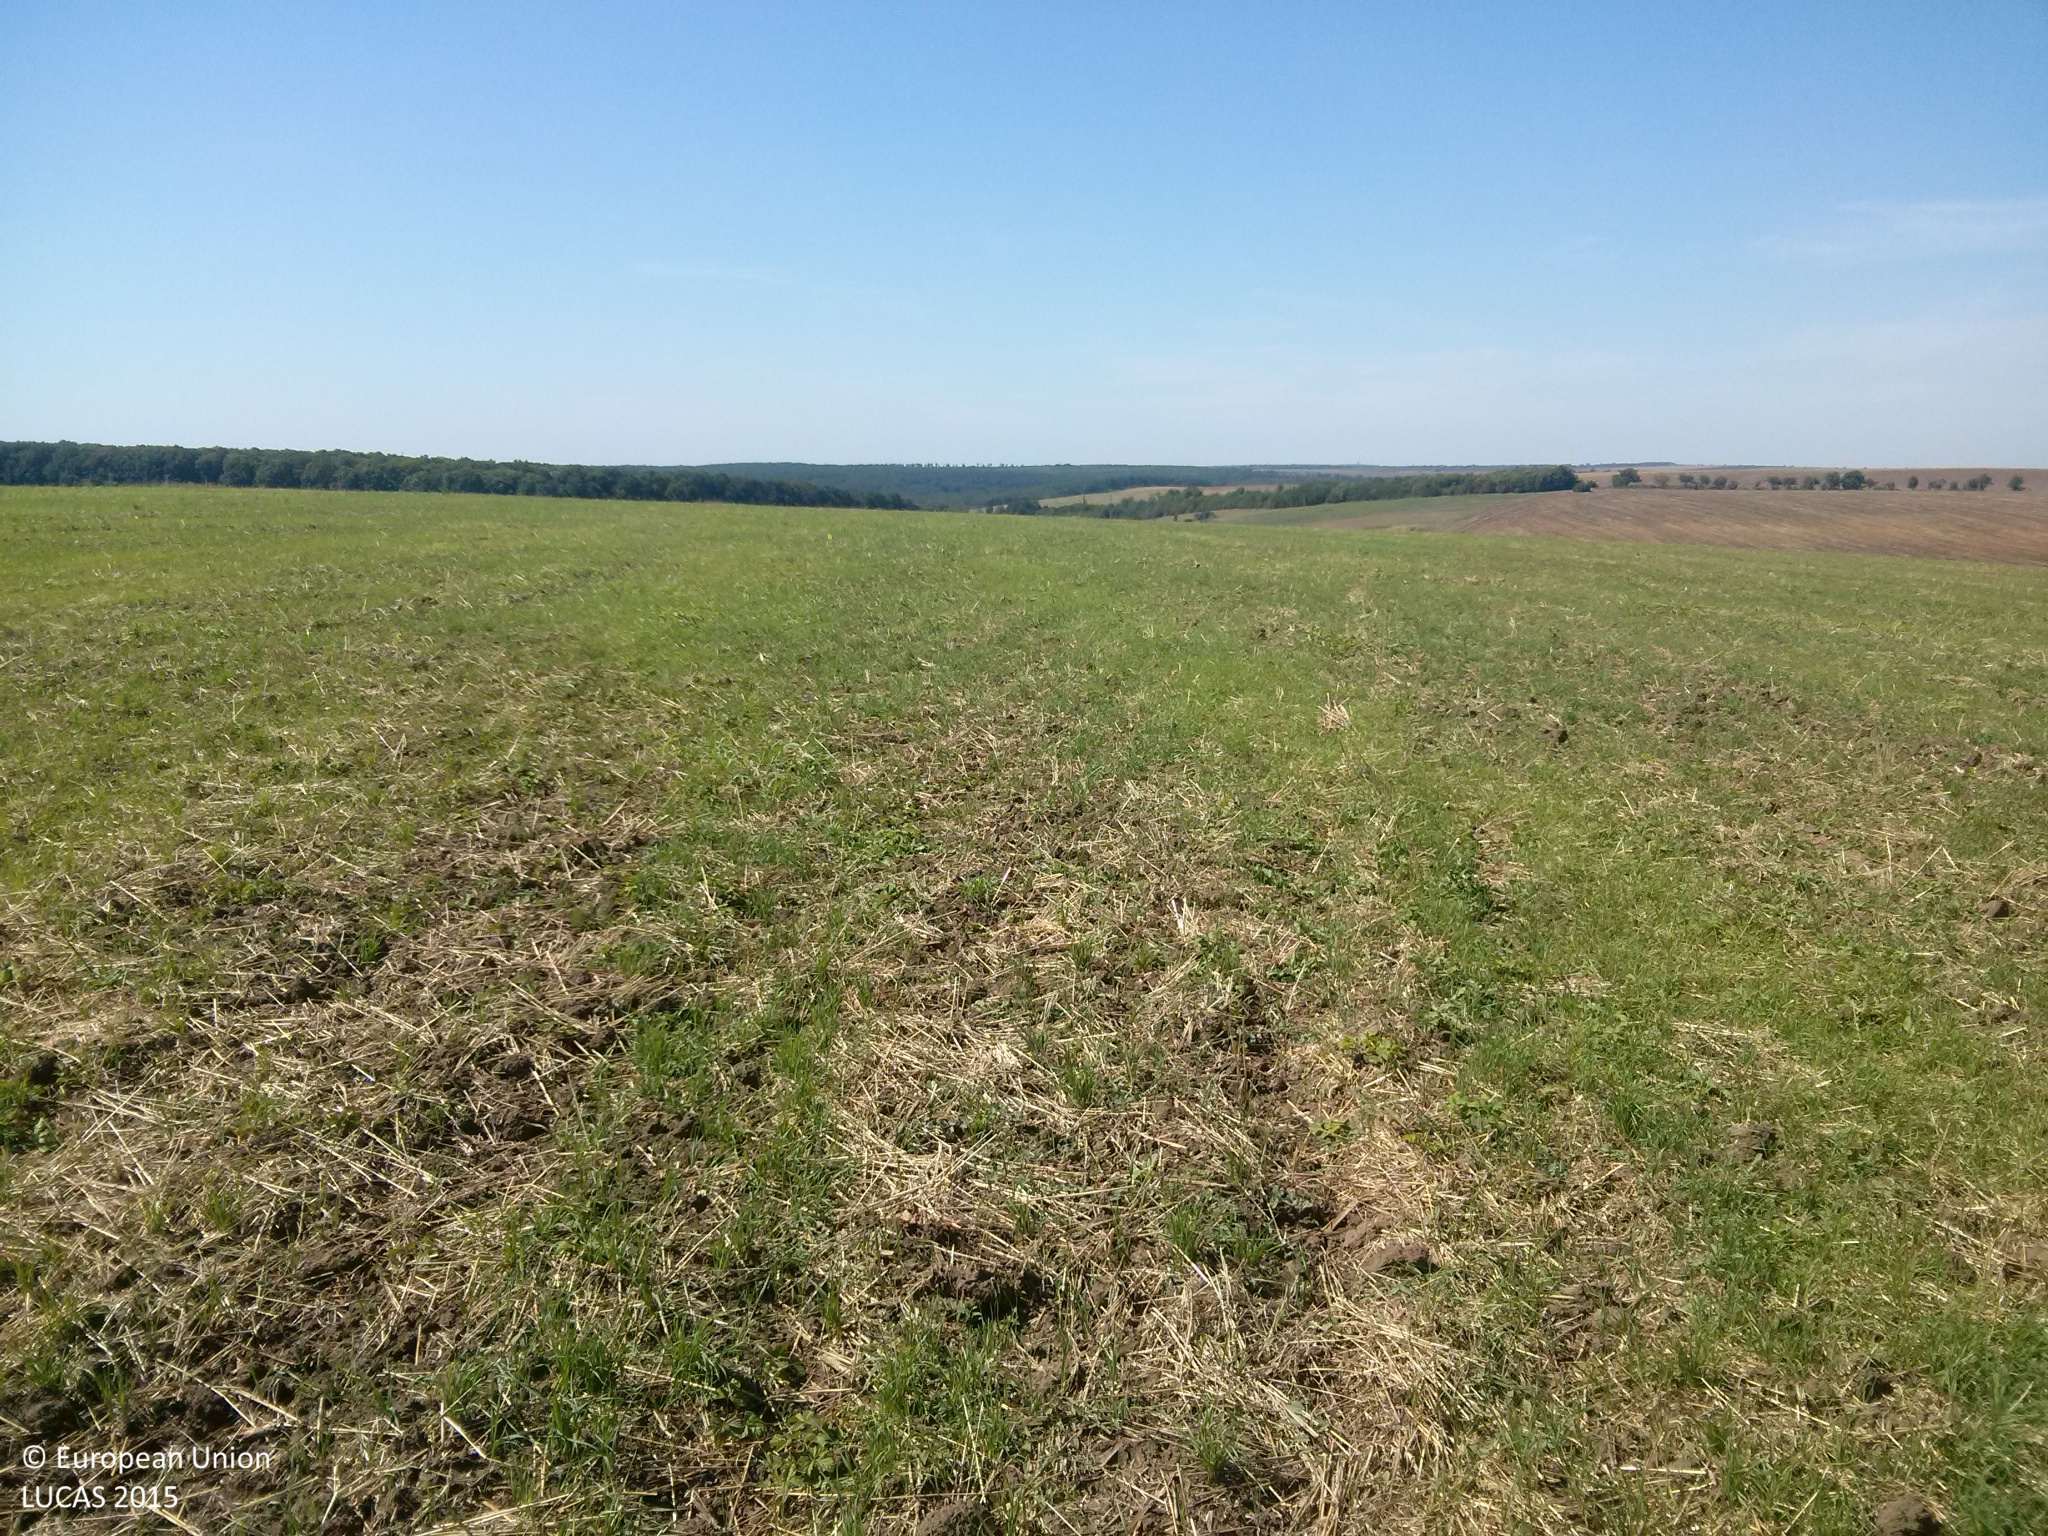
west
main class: Cropland
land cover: Common wheat
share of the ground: < 10 %
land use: Agriculture (excluding fallow land and kitchen gardens)
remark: Harvested field
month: September
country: BG
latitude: 43.6757
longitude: 26.4152
